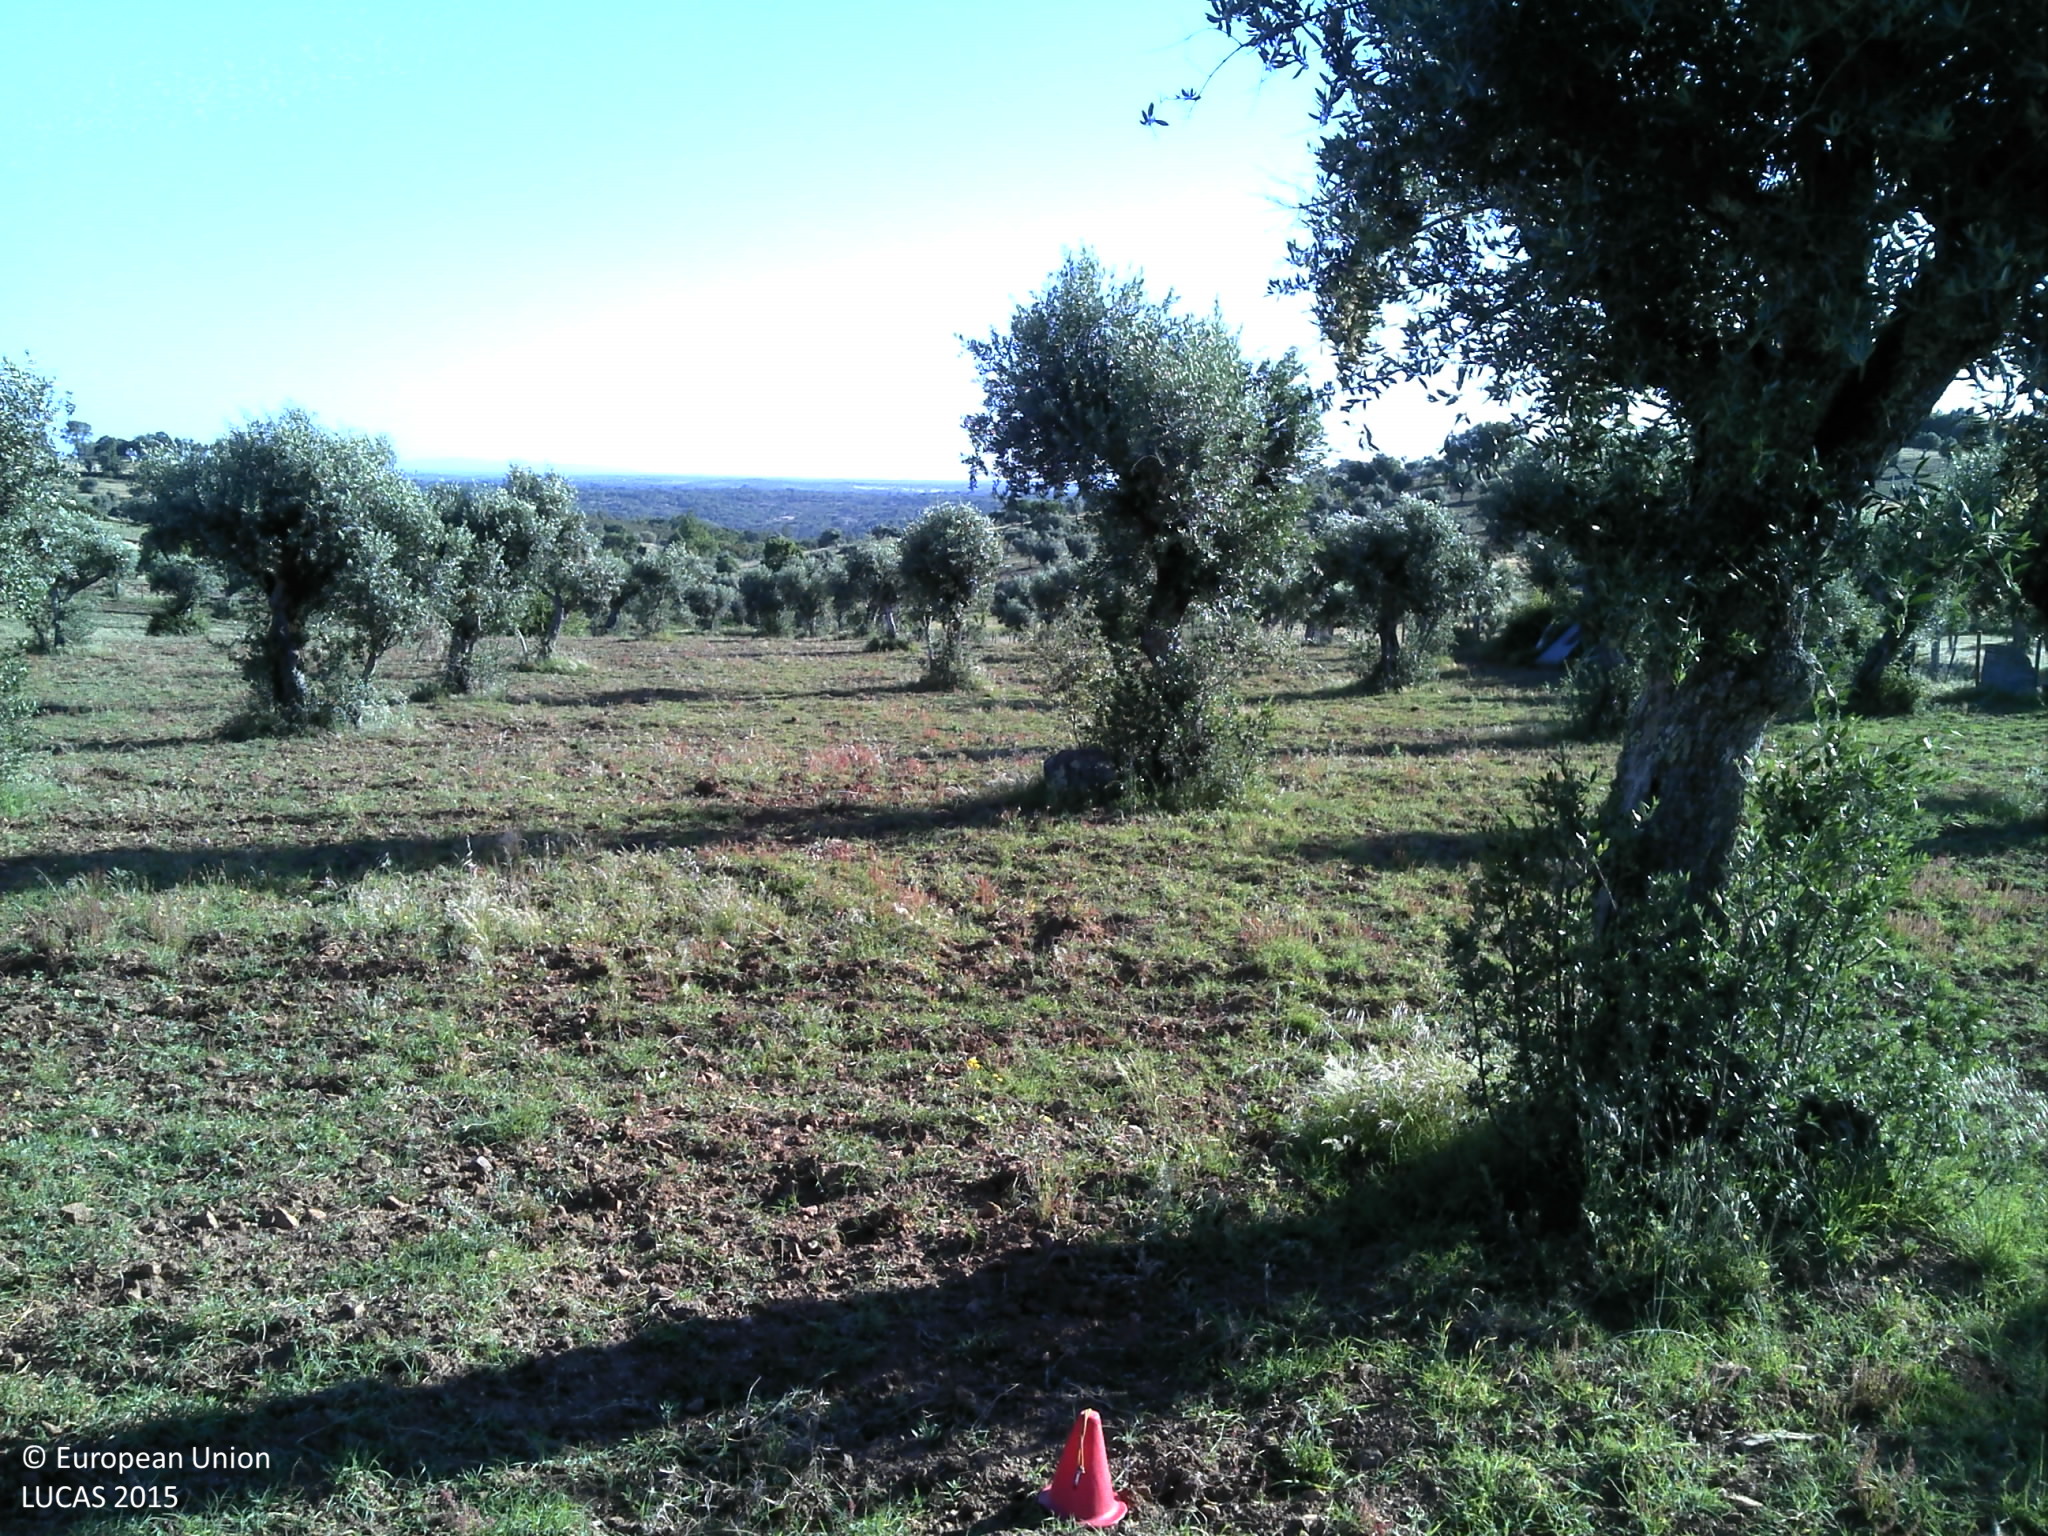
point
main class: Cropland
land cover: Olive groves
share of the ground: 10 - 25 %
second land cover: Grassland without tree/shrub cover
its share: 10 - 25 %
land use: Agriculture (excluding fallow land and kitchen gardens)
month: May
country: PT
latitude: 39.1638
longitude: -7.9797
